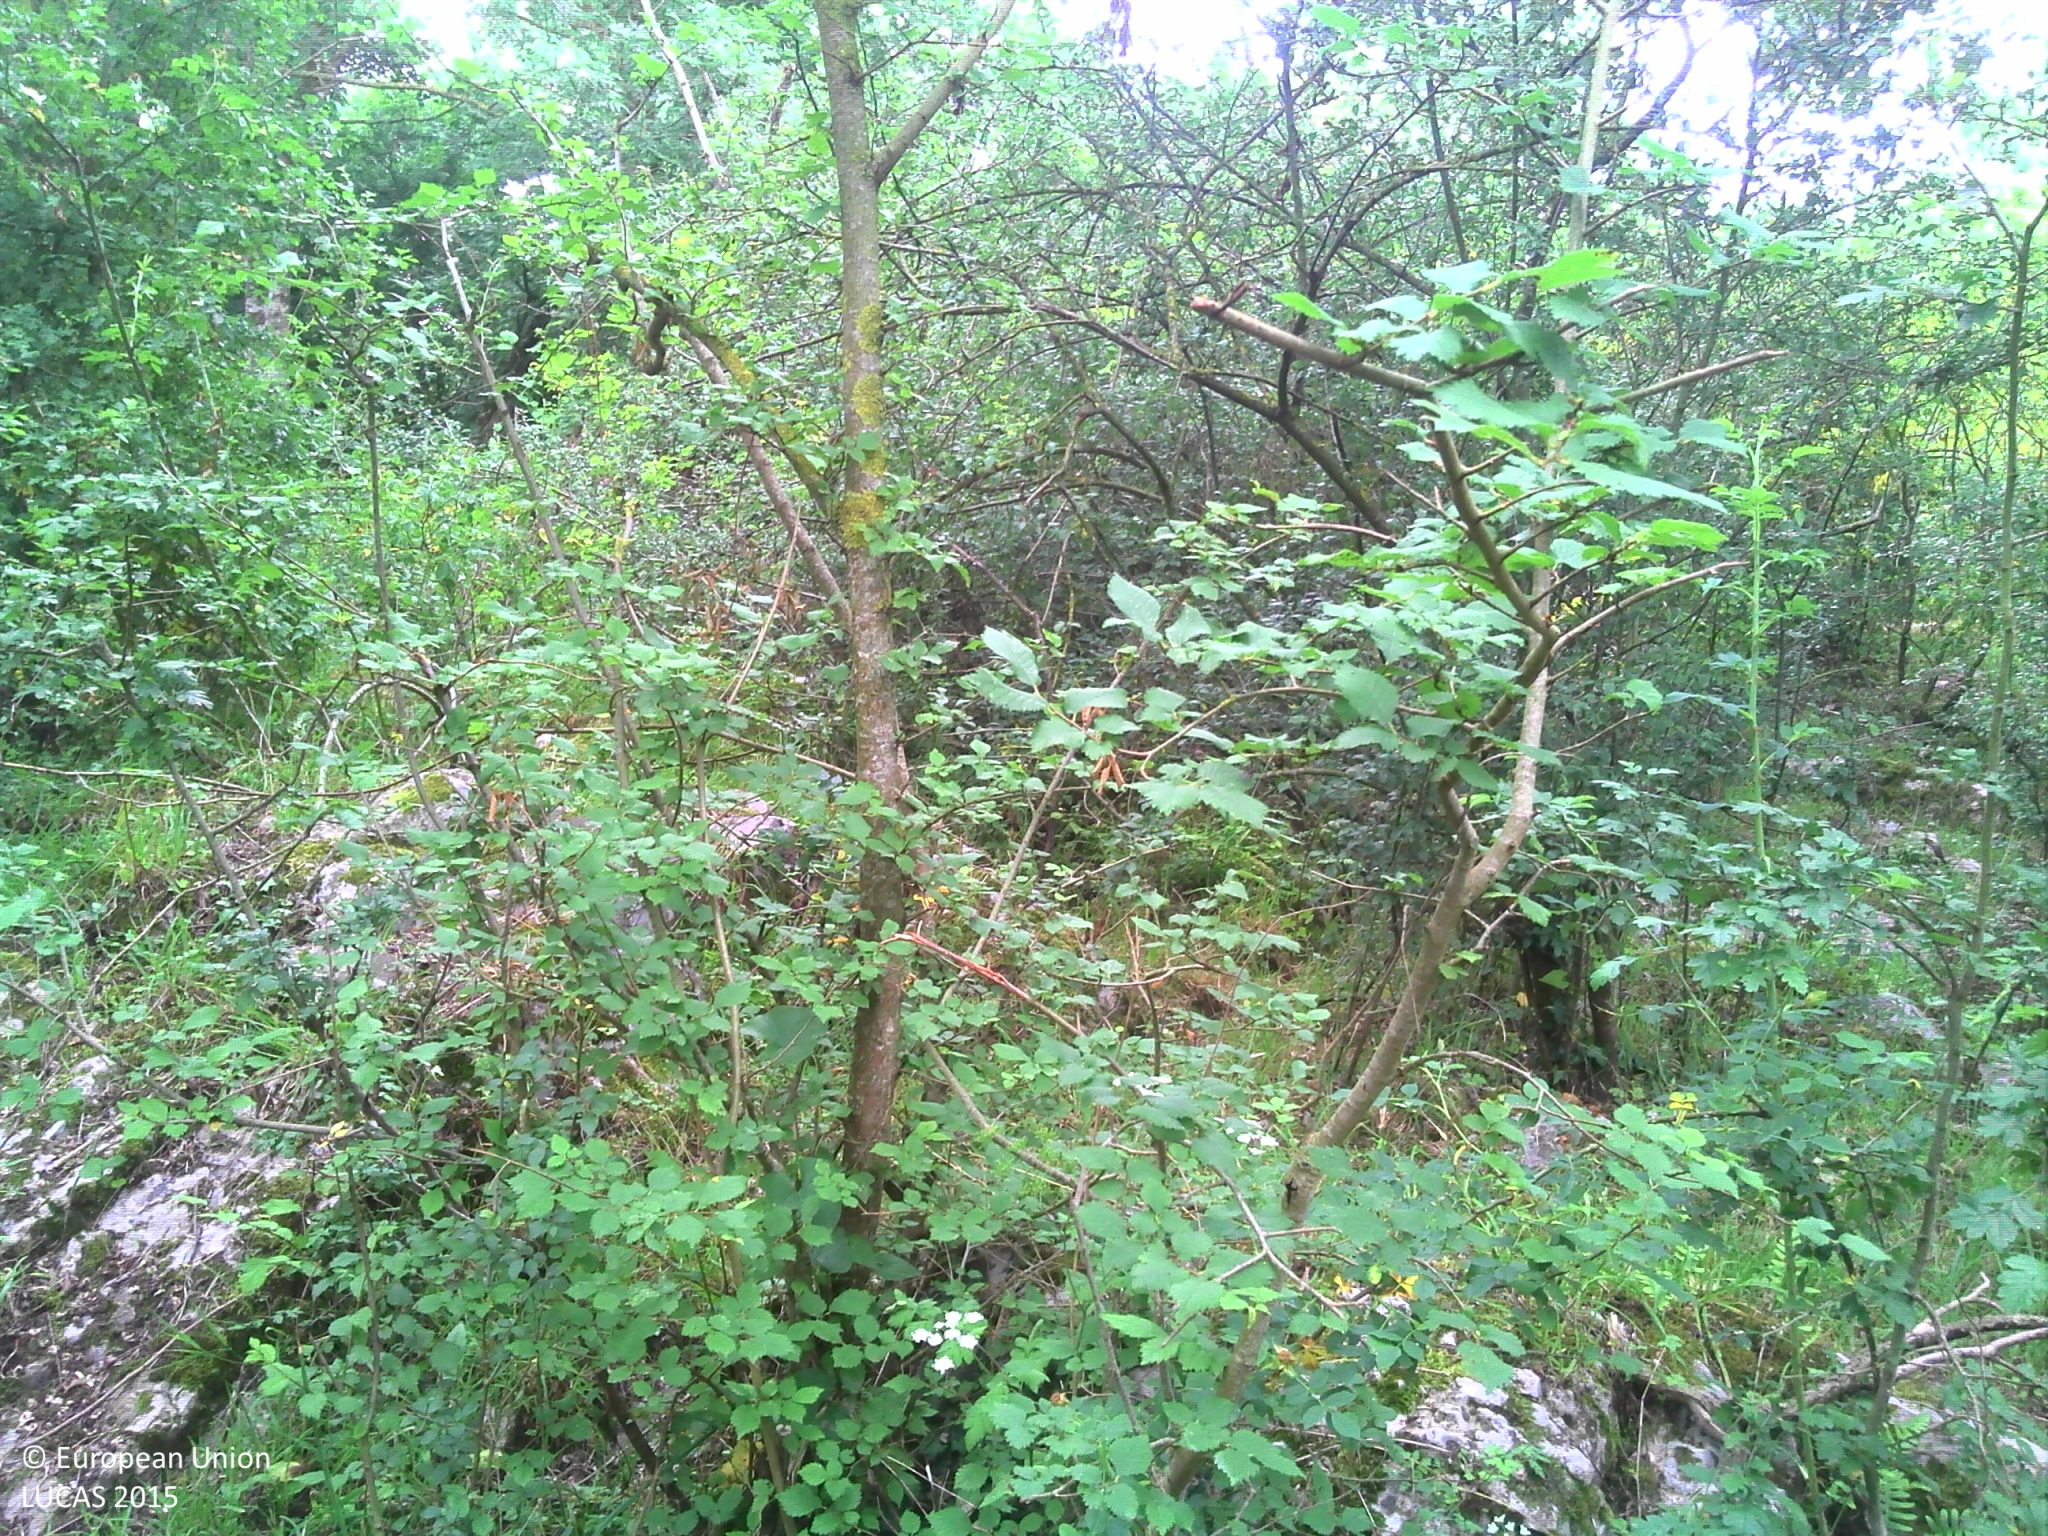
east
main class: Woodland
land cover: Broadleaved woodland
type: mesophytic deciduous forest
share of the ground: > 75 %
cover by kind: broadleaved forest trees 90 %, lichens and mosses 10 %
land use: Forestry
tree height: > 5 m
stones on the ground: 10 - 25 %
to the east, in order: Broadleaved woodland; Tracks; Fences; Tracks; Other bare soil
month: June
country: FR
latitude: 48.8051
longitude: 0.0443
